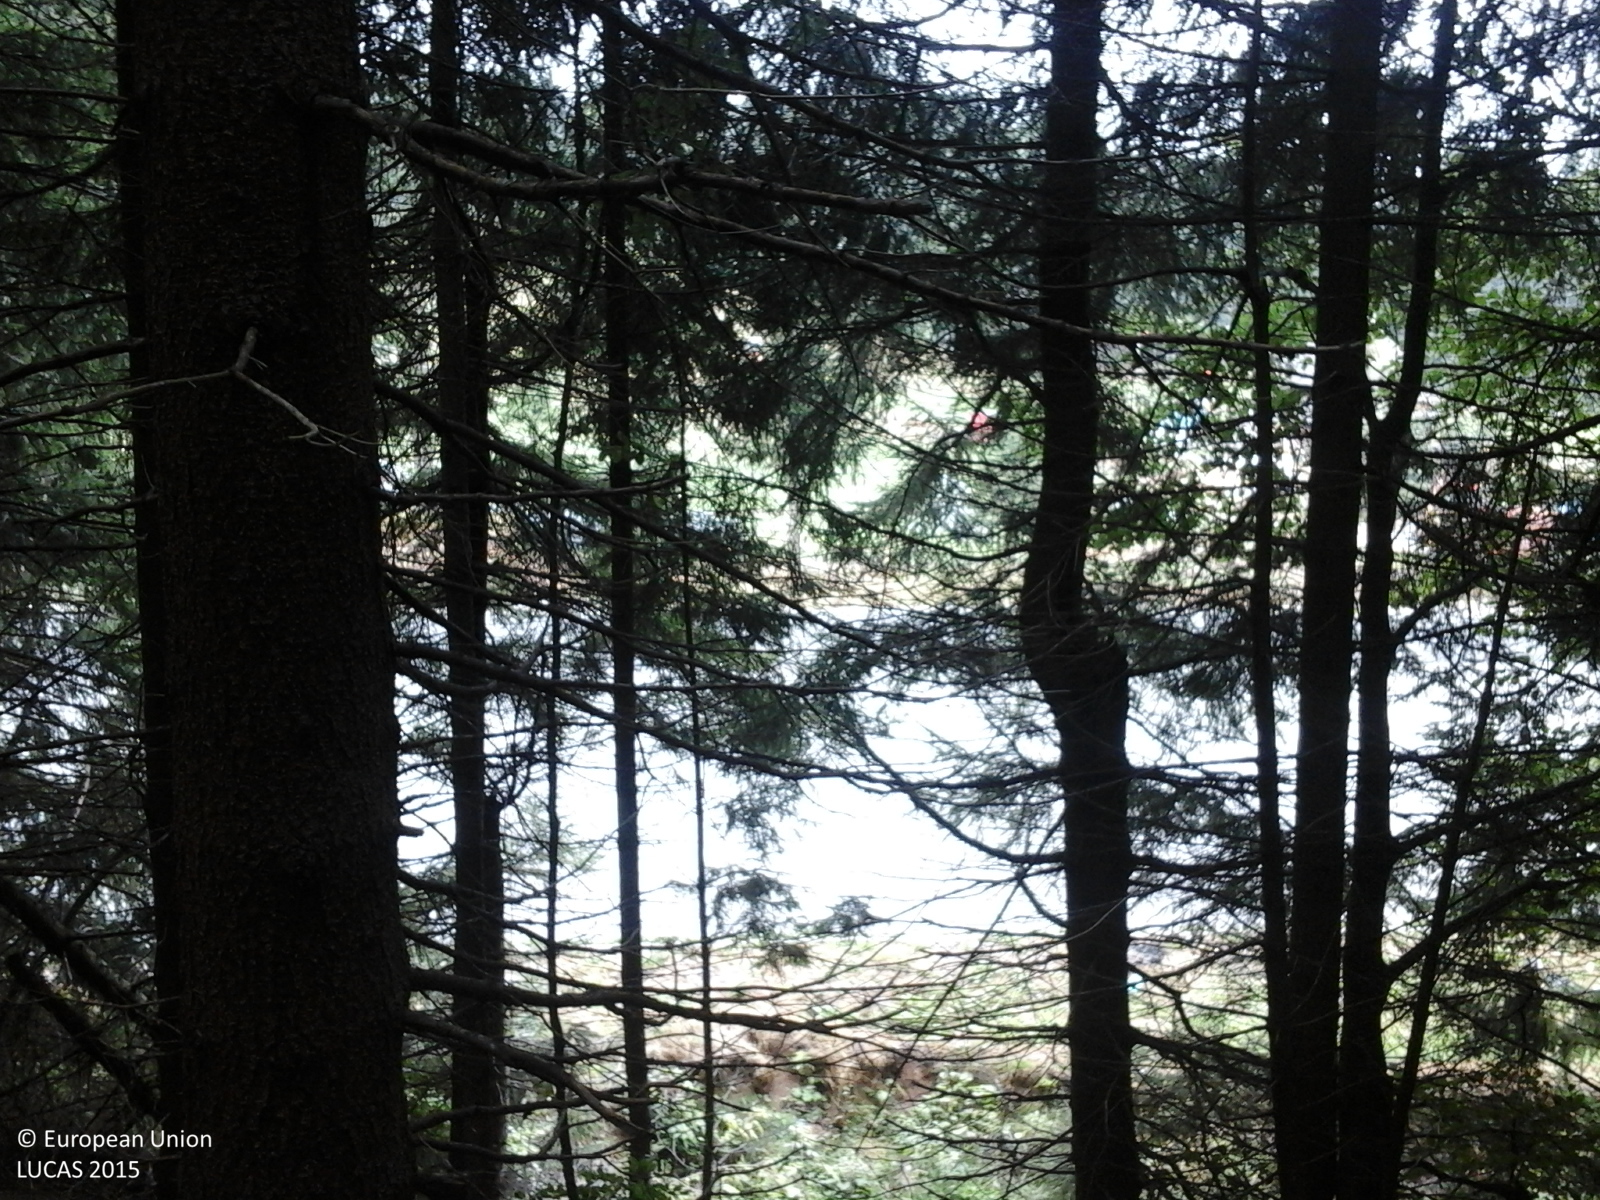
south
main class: Woodland
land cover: Spruce dominated mixed woodland
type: alpine coniferous forest
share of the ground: > 75 %
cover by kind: coniferous forest trees 70 %, broadleaved forest trees 30 %
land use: Forestry
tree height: > 5 m
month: September
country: RO
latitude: 47.6672
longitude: 23.8923
